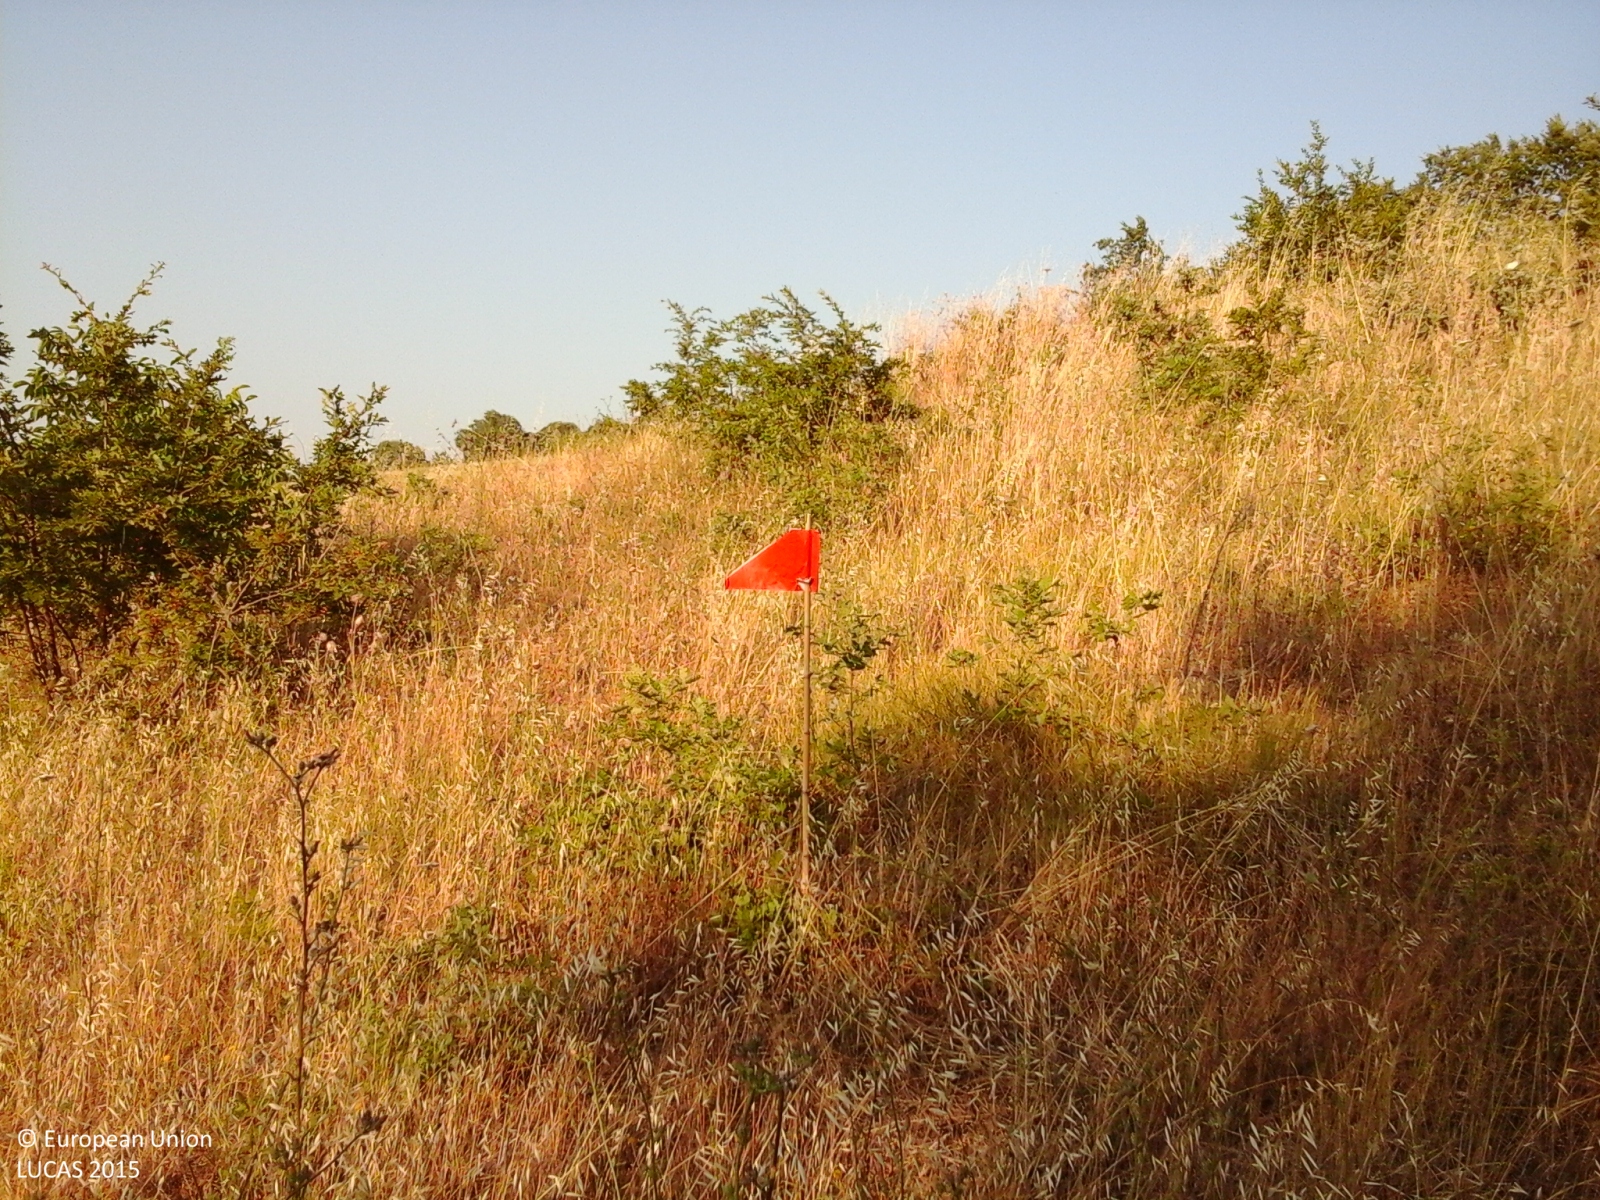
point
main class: Grassland
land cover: Grassland with sparse tree/shrub cover
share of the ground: > 75 %
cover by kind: herbaceous plants 90 %, broadleaved forest trees 5 %, shrubs 5 %
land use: Agriculture (excluding fallow land and kitchen gardens)
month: July
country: IT
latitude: 41.4946
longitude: 14.7149
